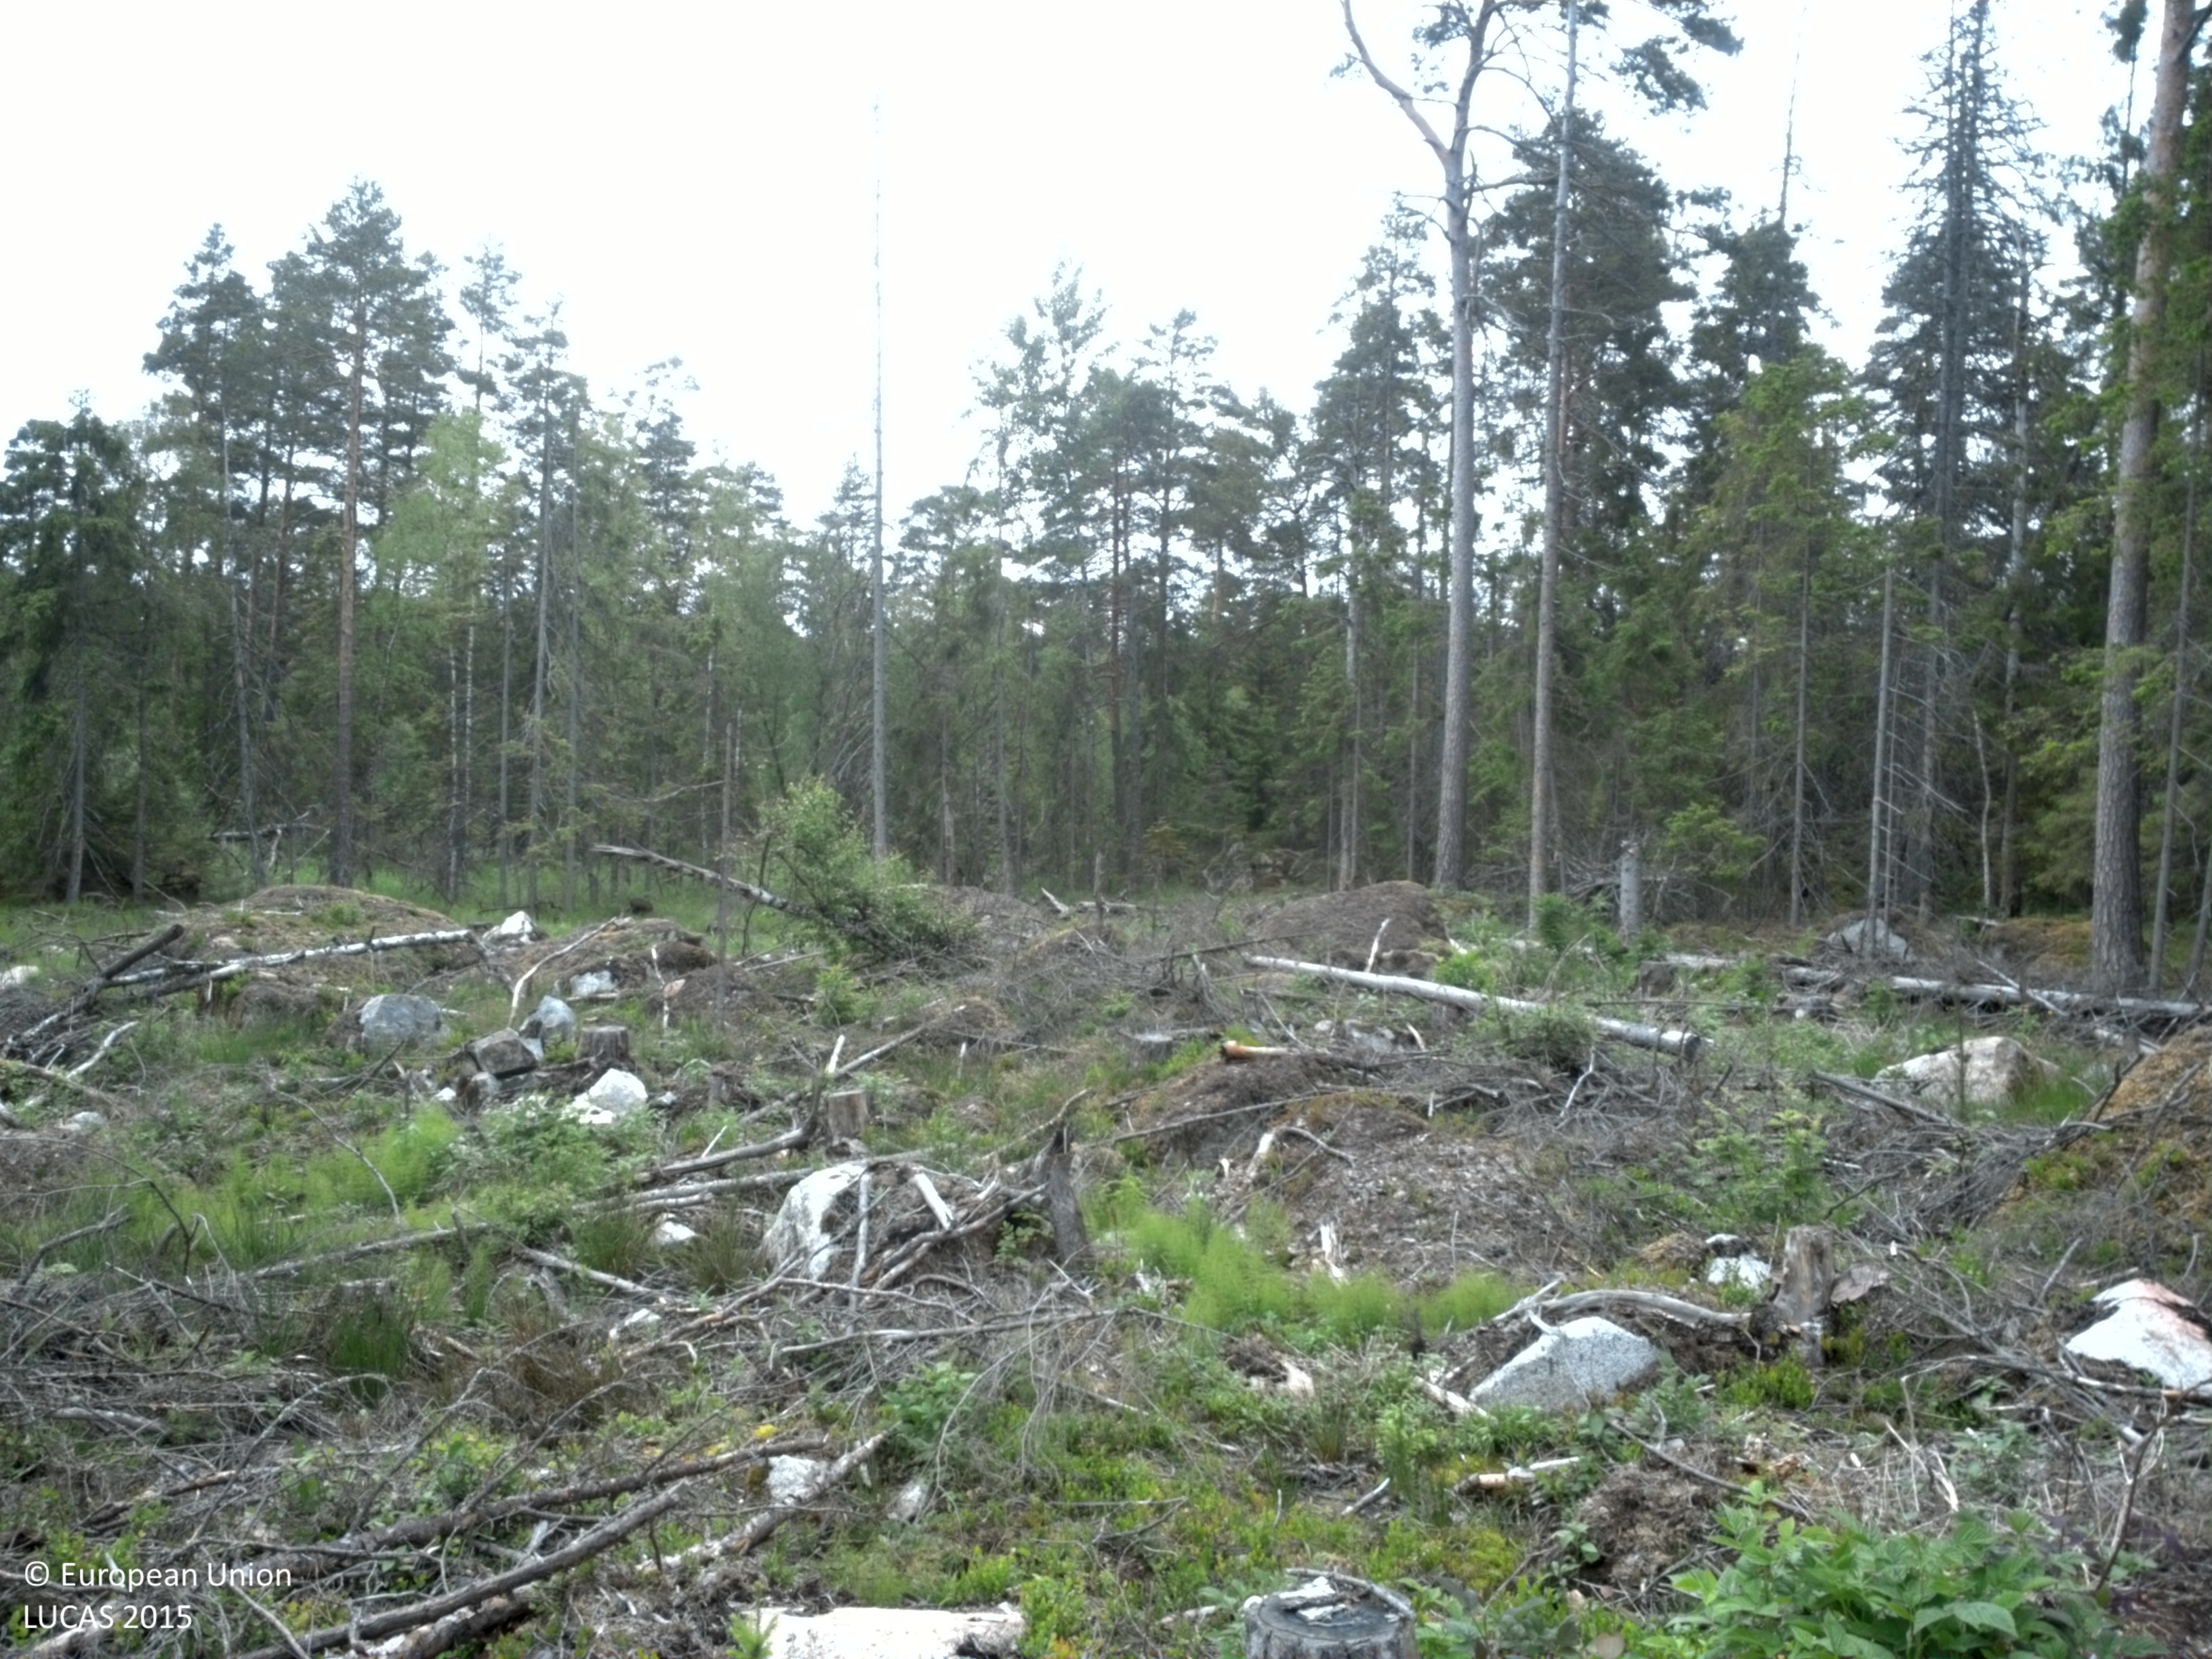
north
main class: Shrubland
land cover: Shrubland without tree cover
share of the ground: < 10 %
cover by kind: lichens and mosses 70 %, herbaceous plants 20 %, shrubs 10 %
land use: Forestry
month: June
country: SE
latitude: 59.6631
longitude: 17.0044
